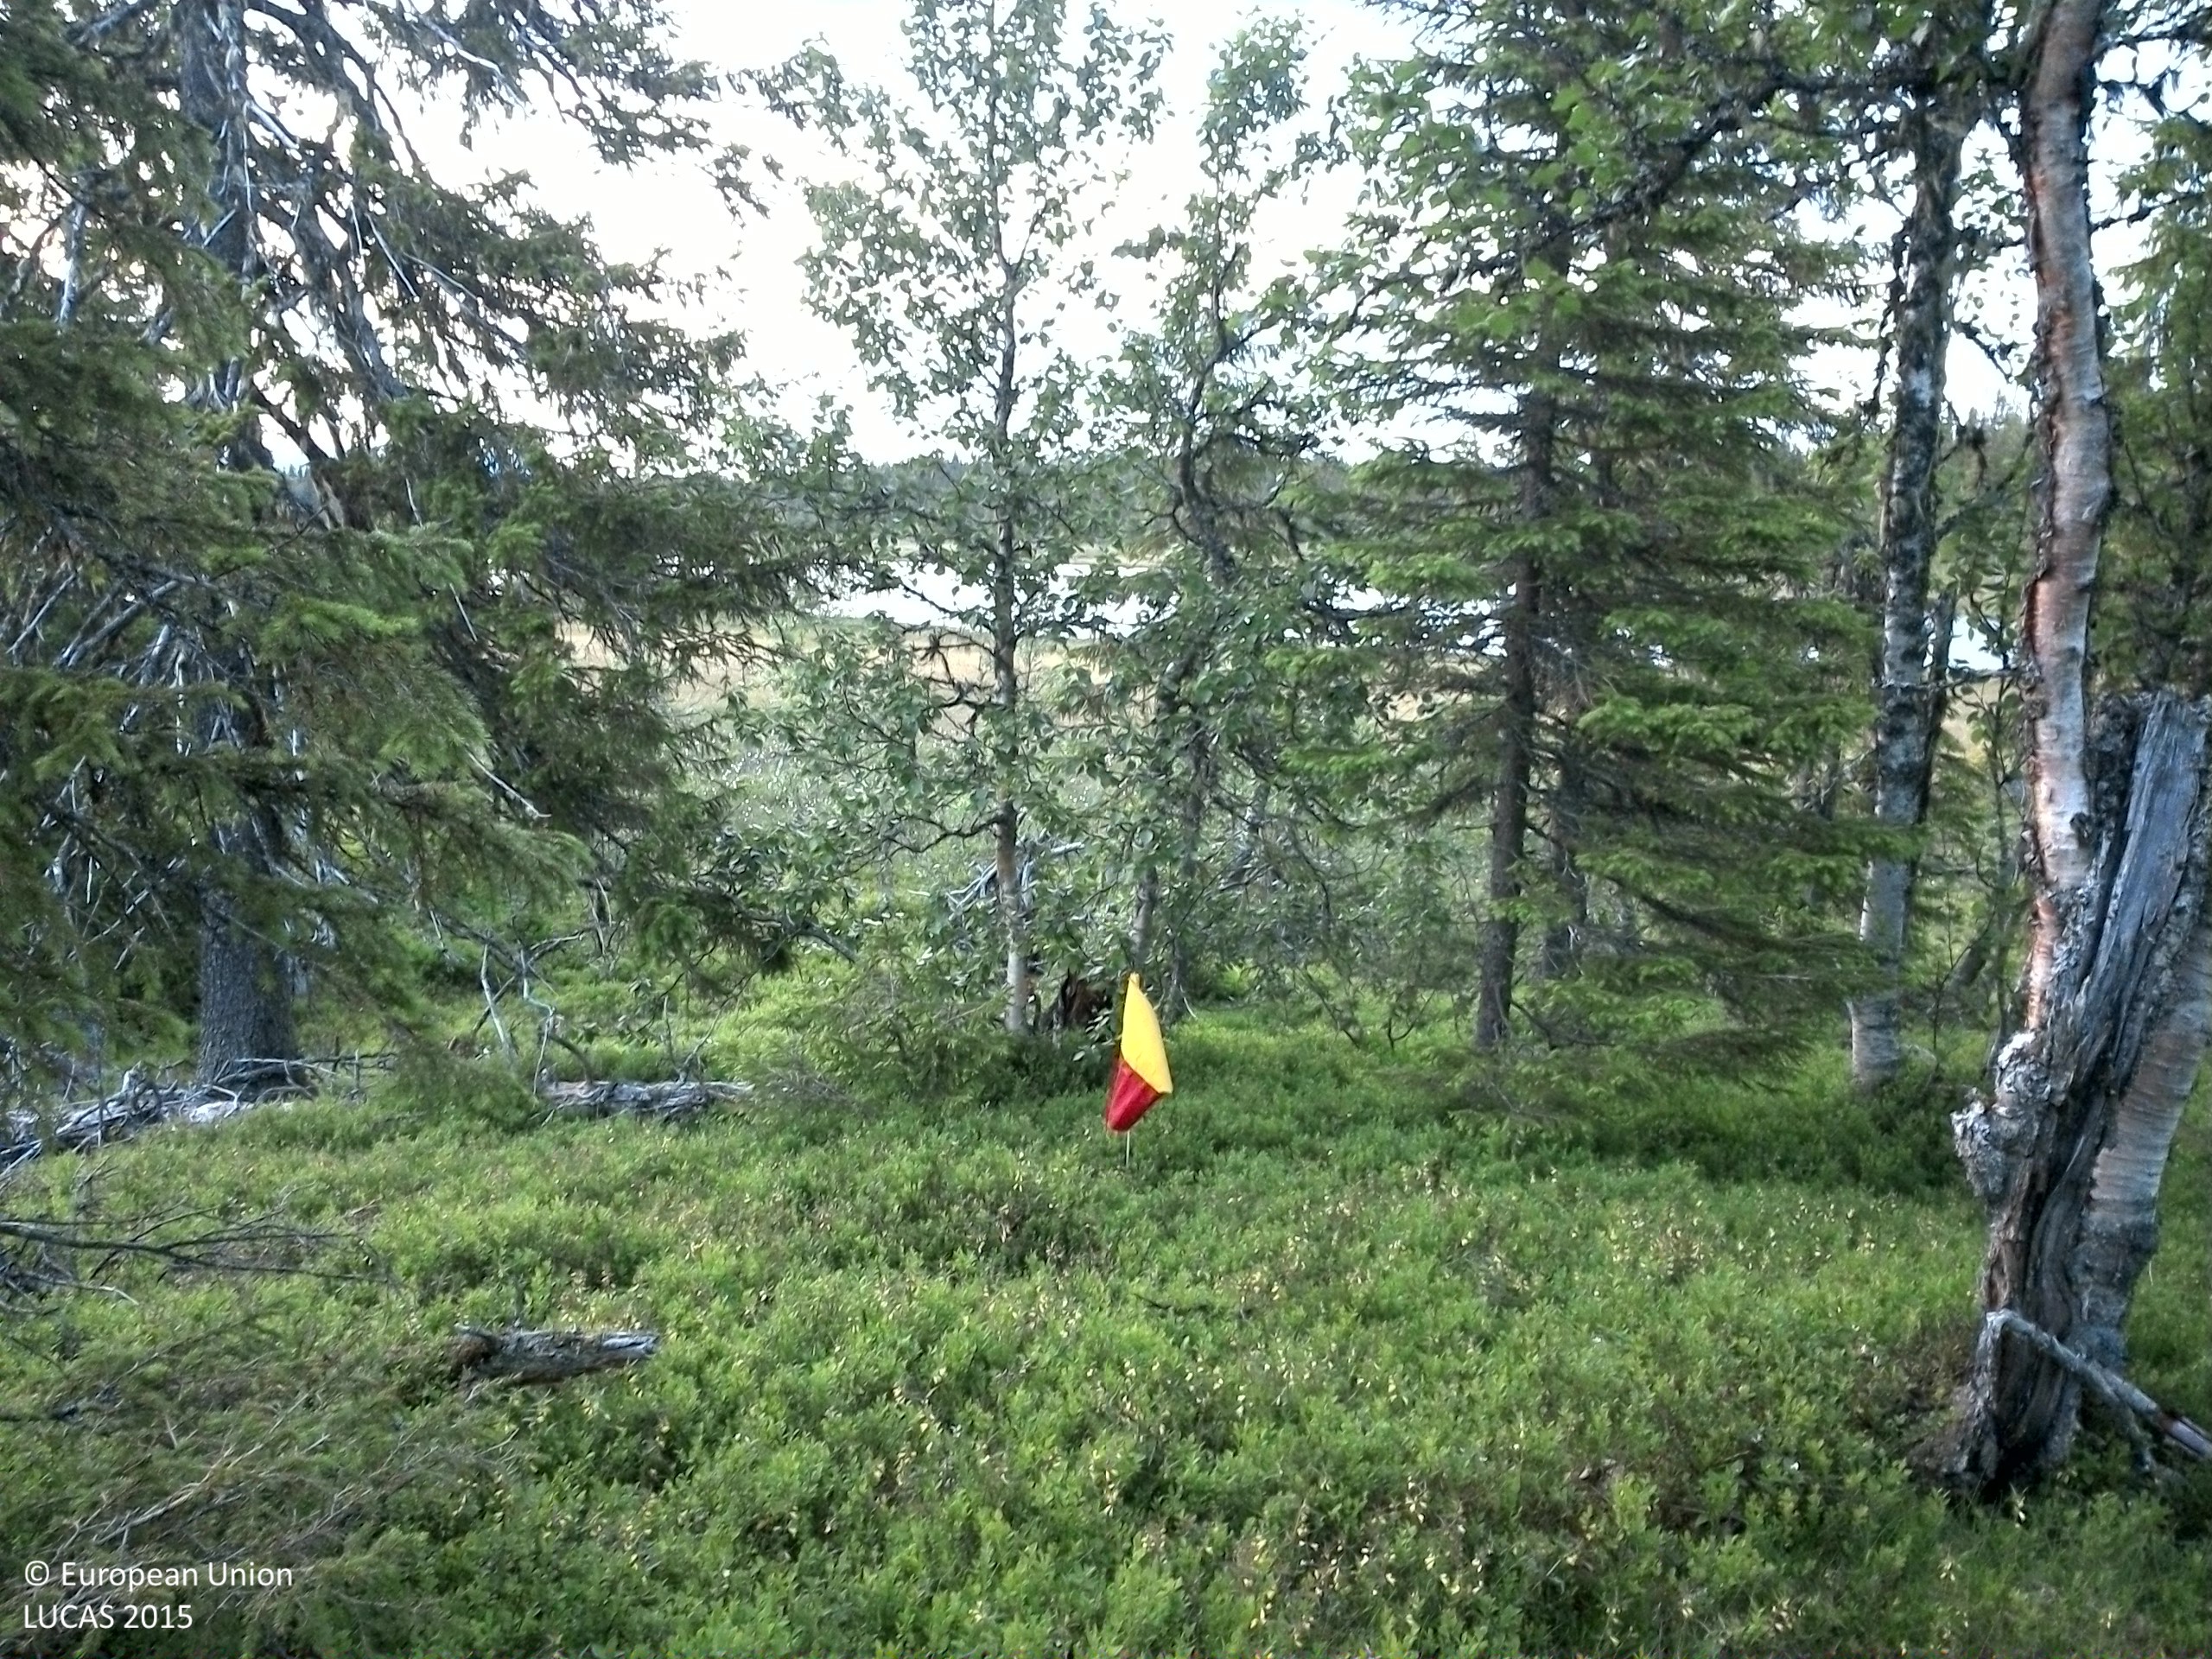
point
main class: Woodland
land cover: Spruce dominated mixed woodland
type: boreal forest
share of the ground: 25 - 50 %
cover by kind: shrubs 50 %, coniferous forest trees 25 %, broadleaved forest trees 15 %, herbaceous plants 10 %
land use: Amenities, museums, leisure
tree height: > 5 m
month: July
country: SE
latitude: 64.6794
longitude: 15.6060
